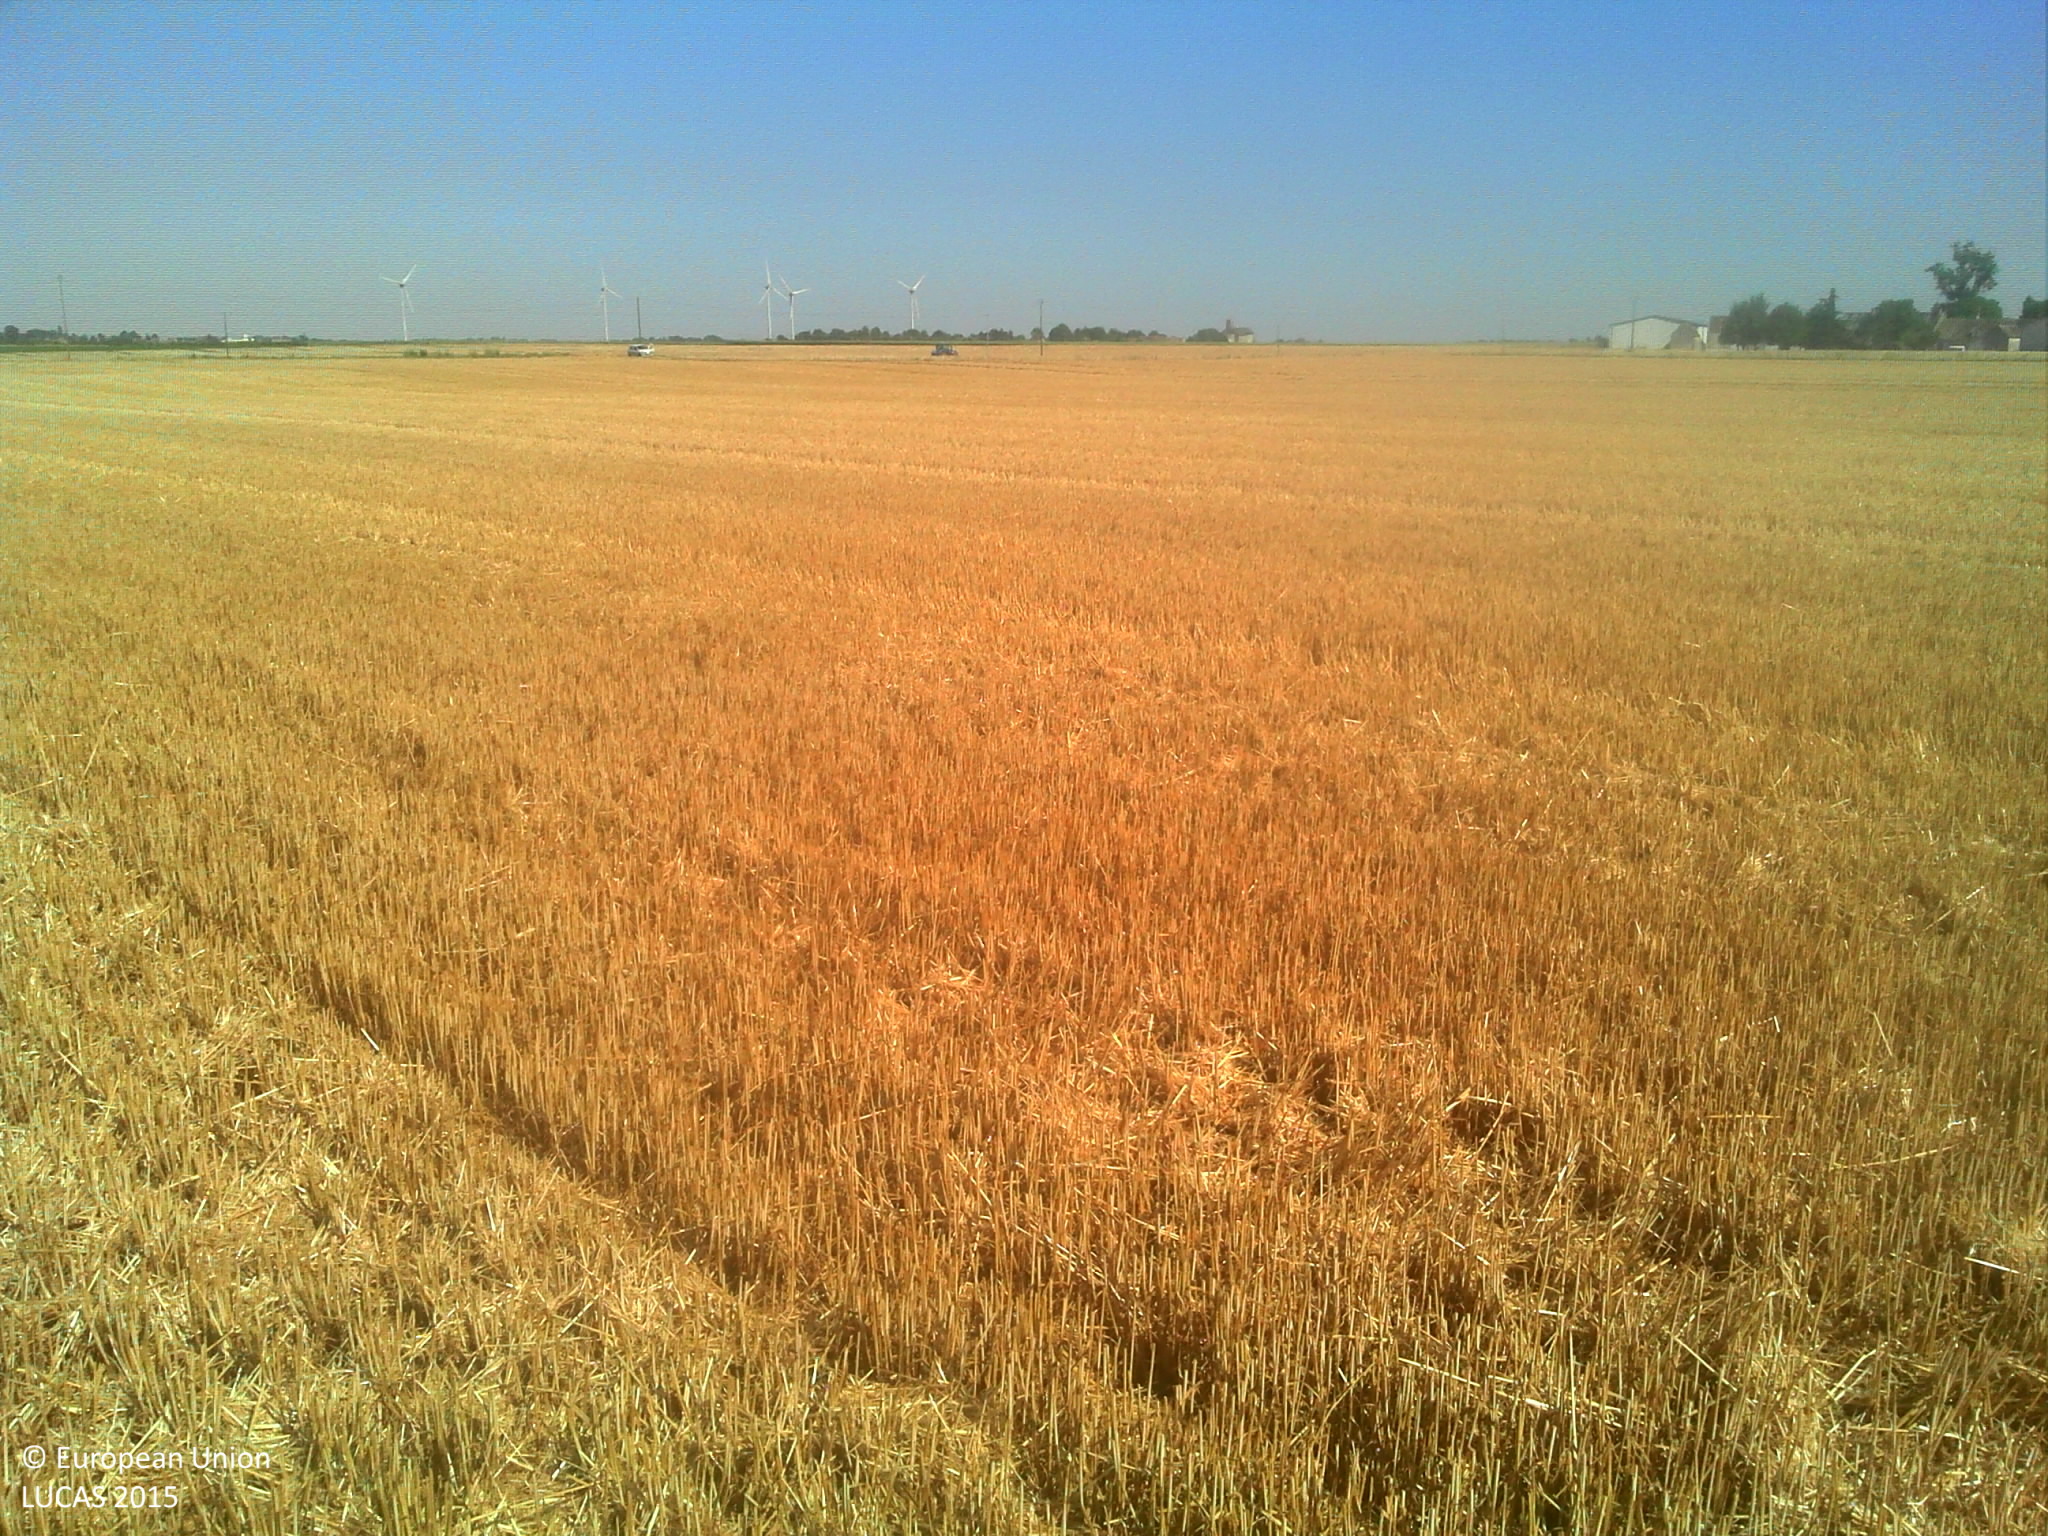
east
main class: Cropland
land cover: Common wheat
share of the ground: > 75 %
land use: Agriculture (excluding fallow land and kitchen gardens)
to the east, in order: Common wheat; Grass margins; Paved roads, cycling and walking lanes; Grass margins; Electric lines; Durum wheat
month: July
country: FR
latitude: 47.8921
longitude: 1.4649
